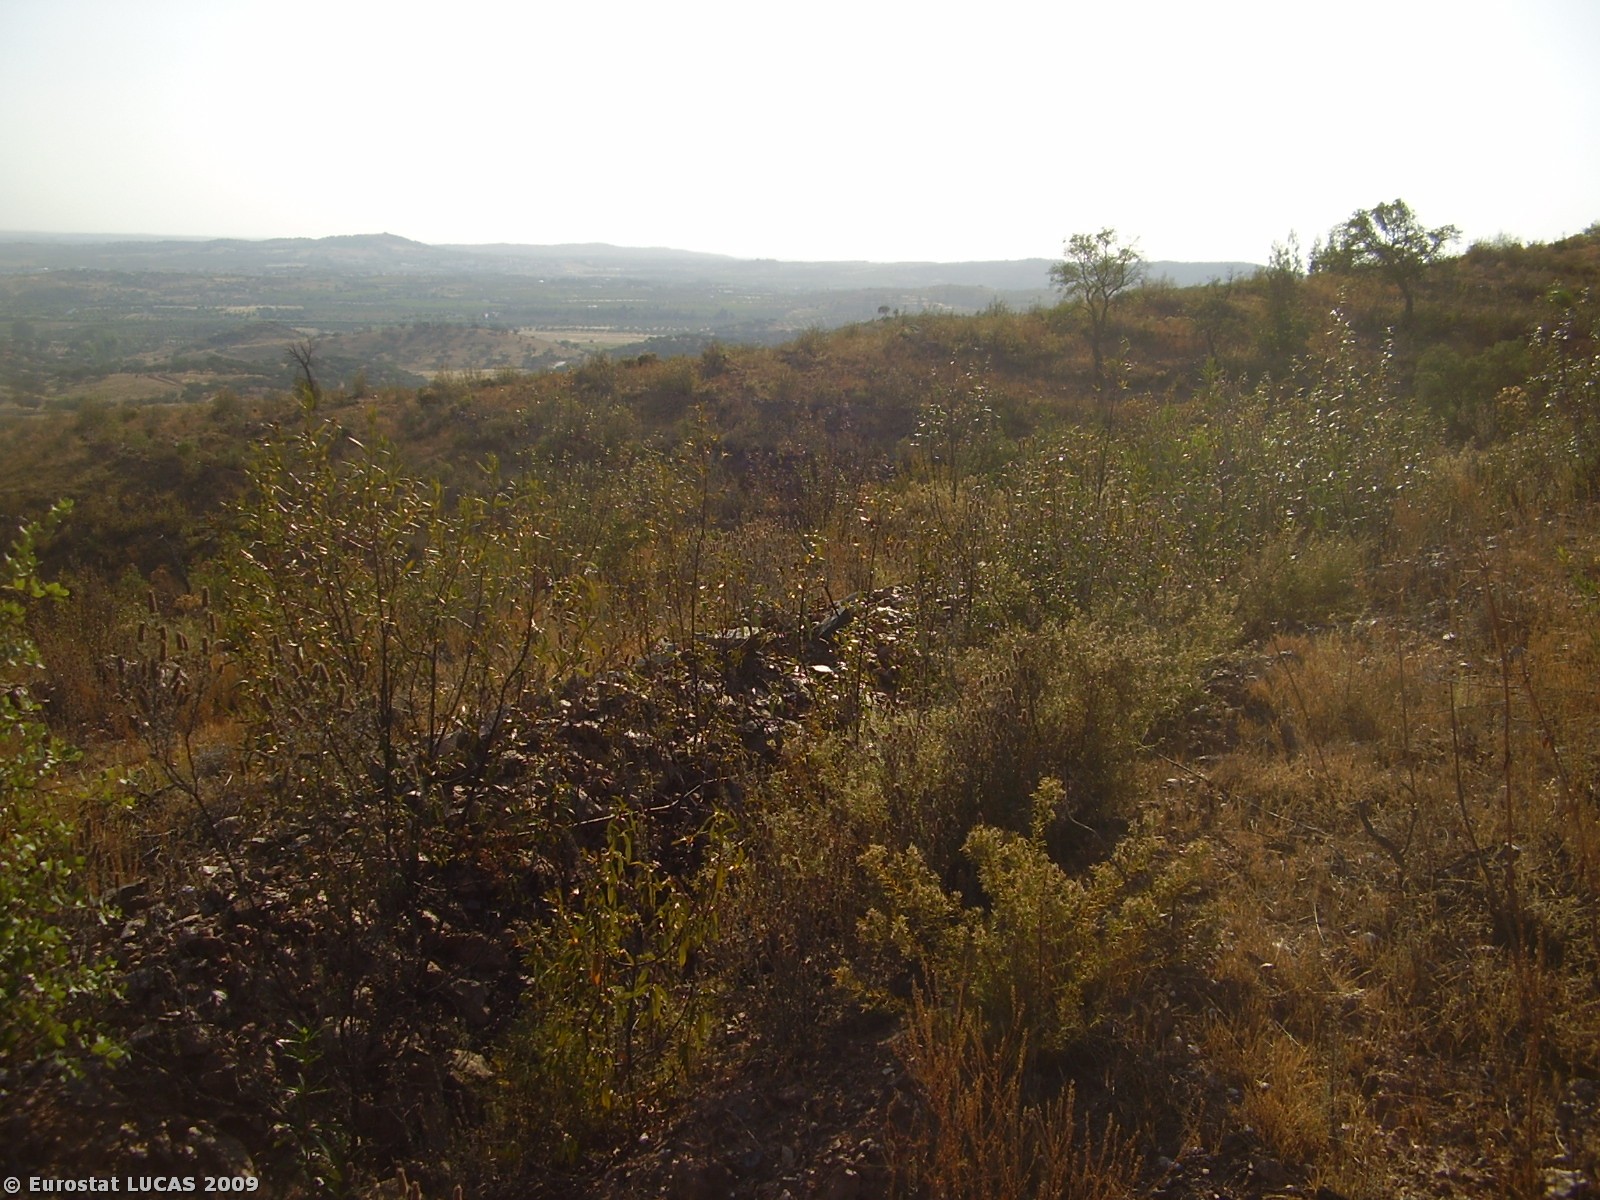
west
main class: Woodland
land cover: Broadleaved woodland
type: broadleaved evergreen forest
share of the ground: 10 - 25 %
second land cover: Shrubland with sparse tree cover
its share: > 75 %
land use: Forestry
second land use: Fallow land
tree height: > 5 m
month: August
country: PT
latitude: 38.2281
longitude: -7.7470
